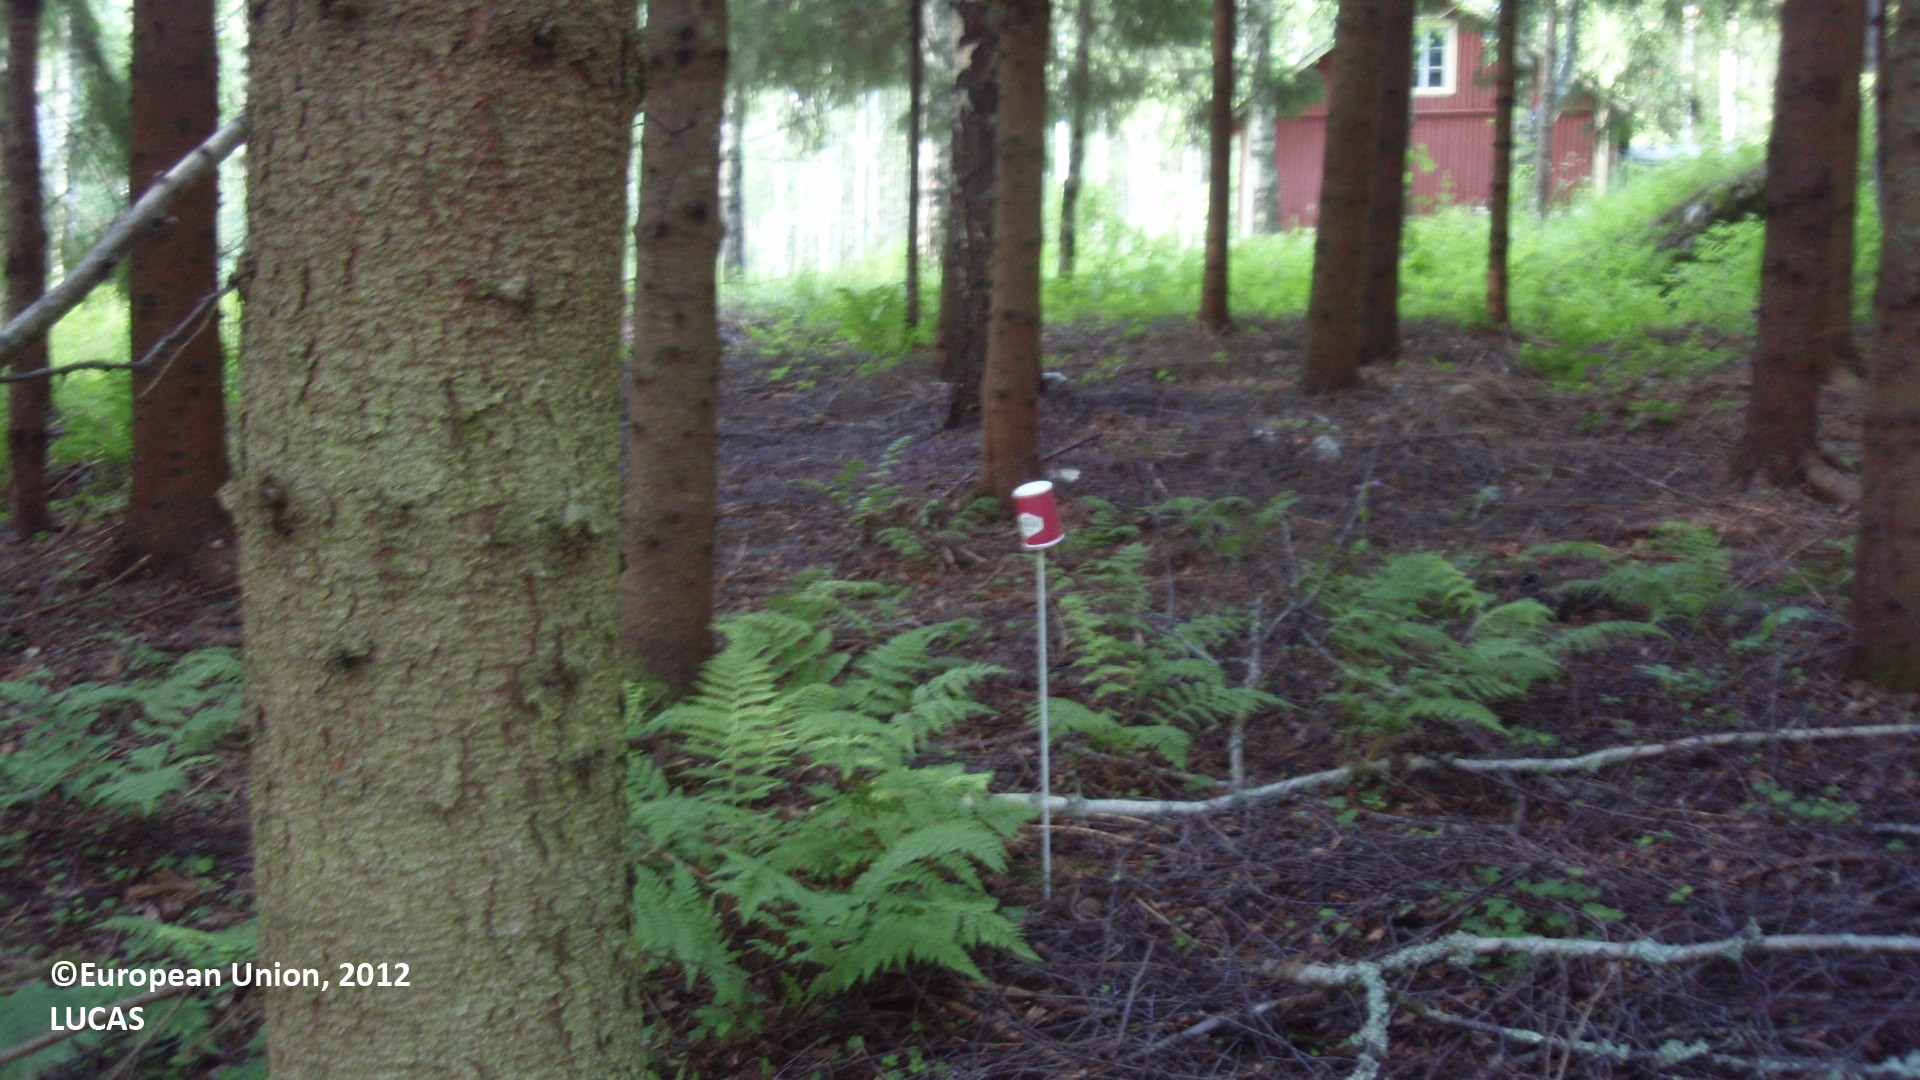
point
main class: Woodland
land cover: Spruce dominated mixed woodland
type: boreal forest
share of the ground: 25 - 50 %
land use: Forestry
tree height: > 5 m
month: July
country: FI
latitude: 61.7120
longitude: 28.1872
